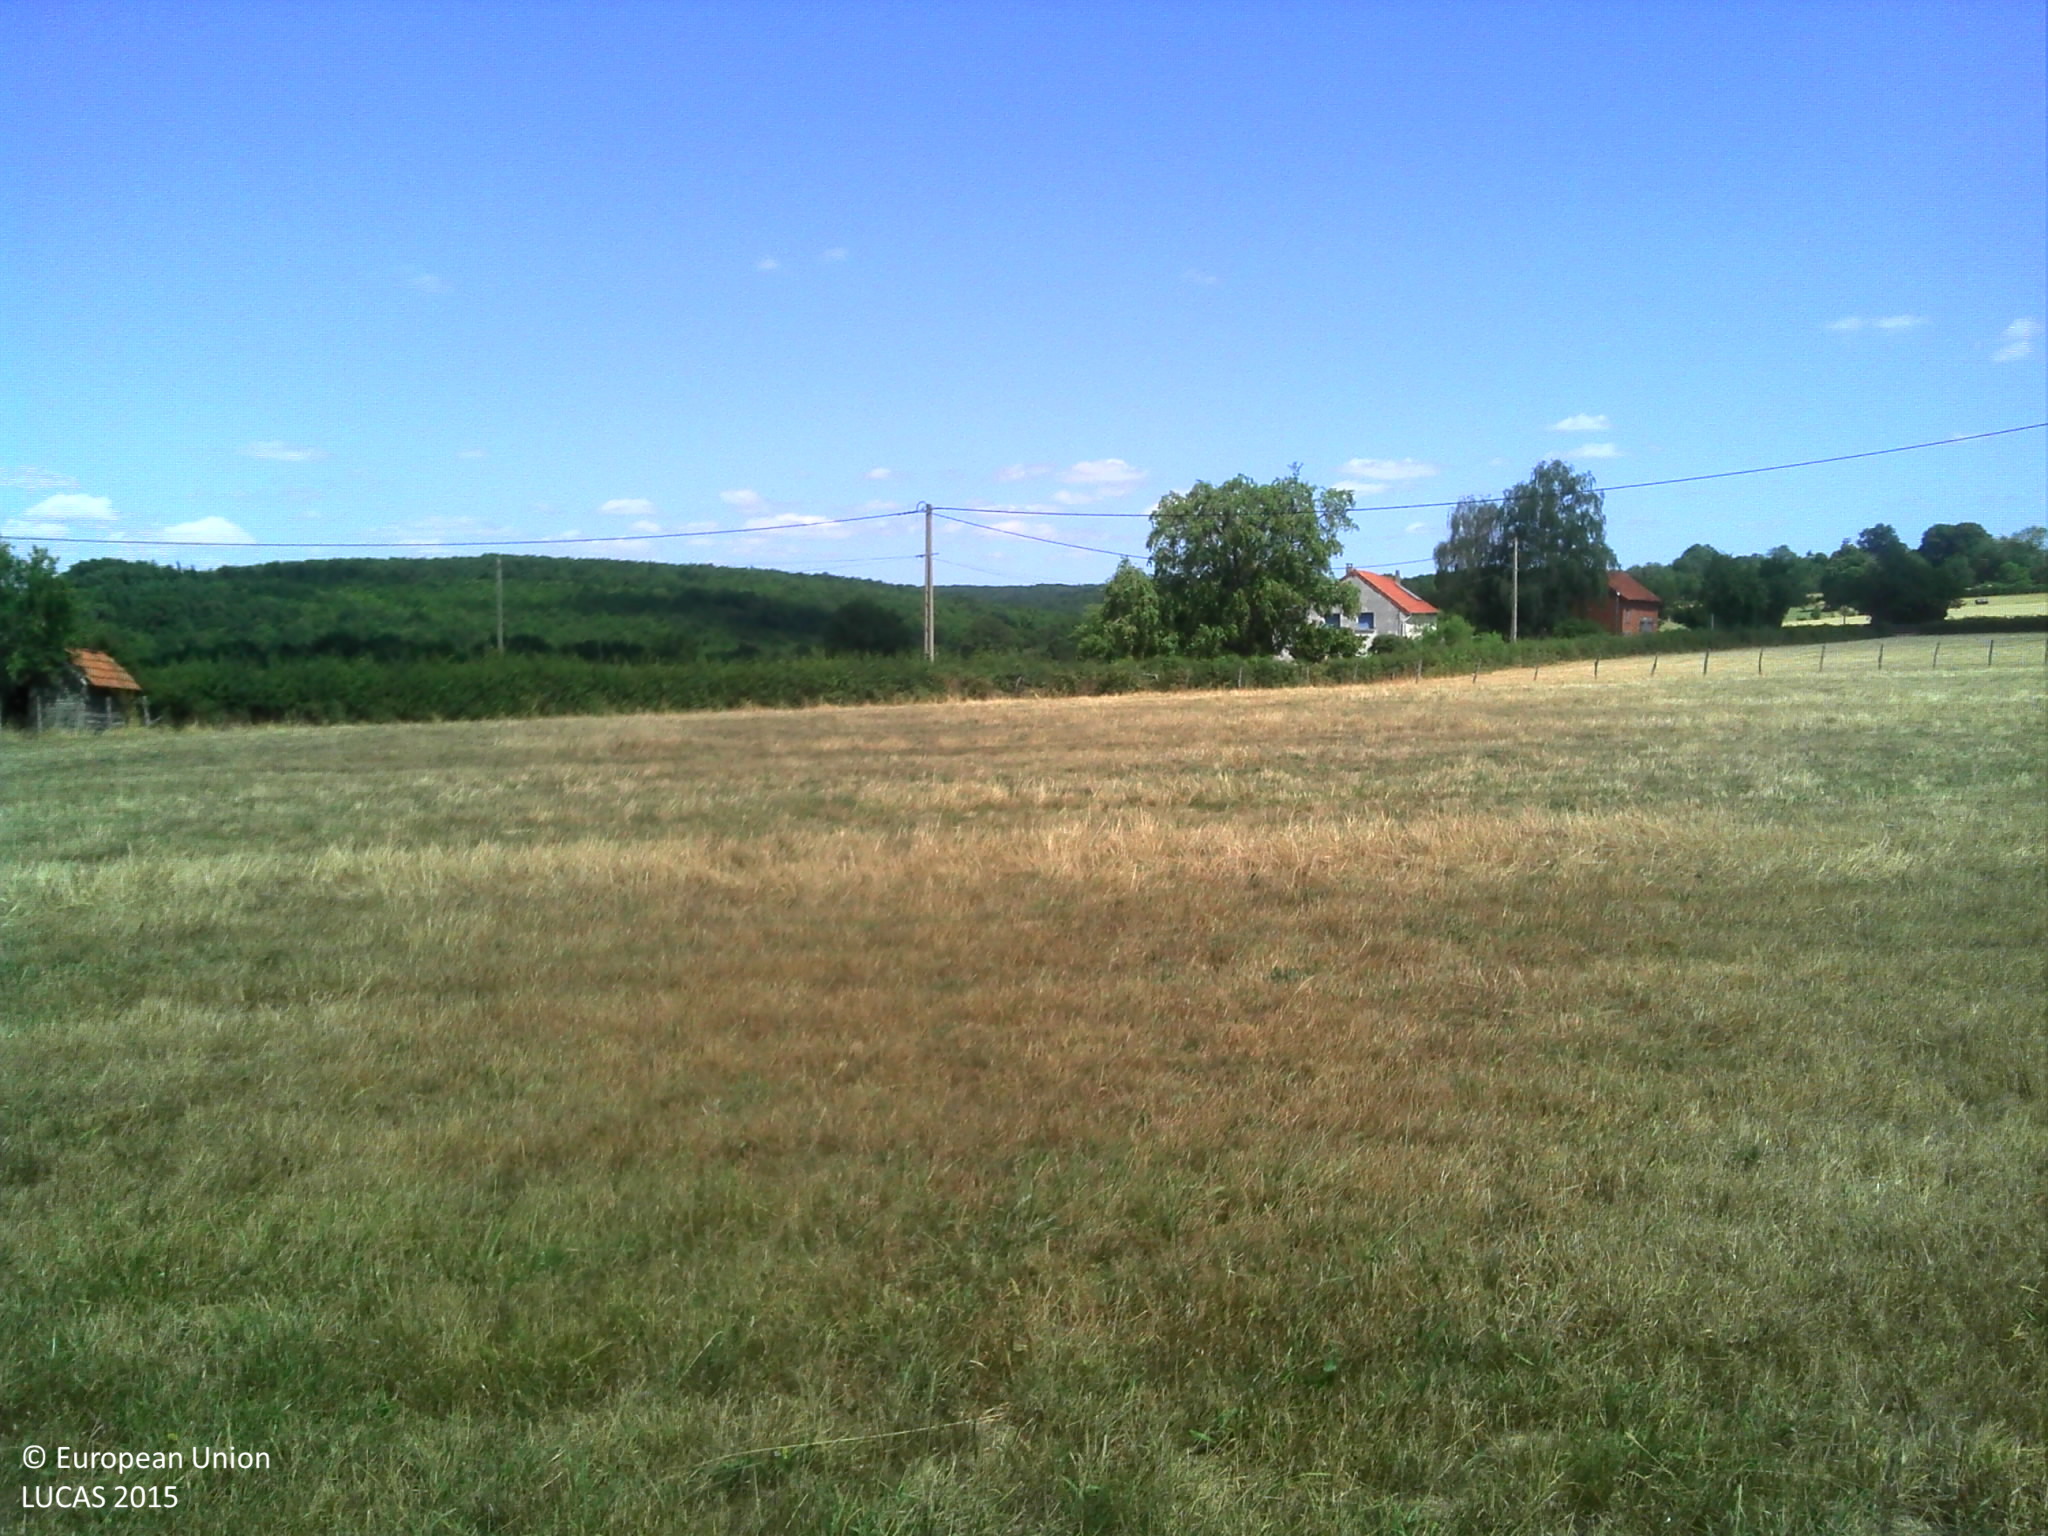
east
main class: Grassland
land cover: Grassland without tree/shrub cover
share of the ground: > 75 %
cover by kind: herbaceous plants 100 %
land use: Agriculture (excluding fallow land and kitchen gardens)
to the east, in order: Grassland without tree/shrub cover; Fences; Electric lines; Managed hedges; Grass margins; Paved roads, cycling and walking lanes; Grass margins; Fences; Grassland without tree/shrub cover; Single bushes/trees
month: July
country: FR
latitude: 46.2770
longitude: 4.0703
